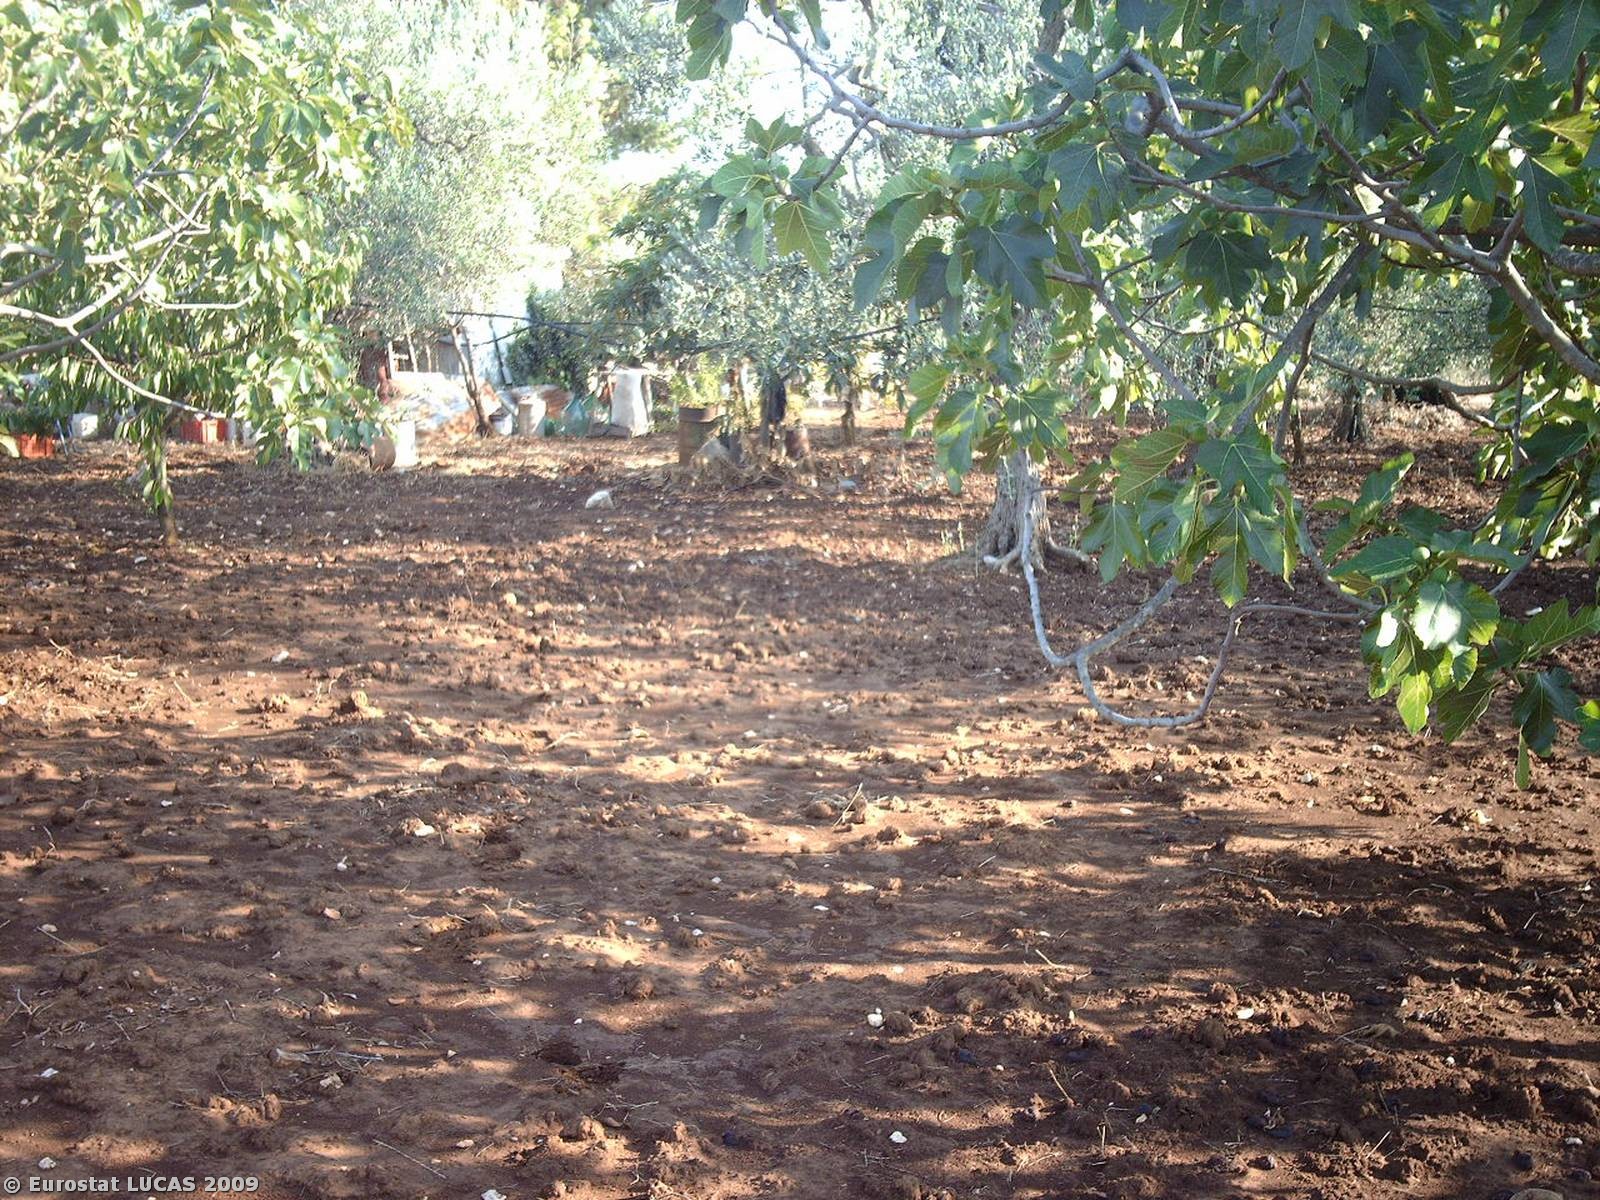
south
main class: Cropland
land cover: Cherry fruit
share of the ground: > 75 %
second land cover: Bare land
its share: > 75 %
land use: Agriculture (excluding fallow land and kitchen gardens)
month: August
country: IT
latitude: 40.9316
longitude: 16.9022
